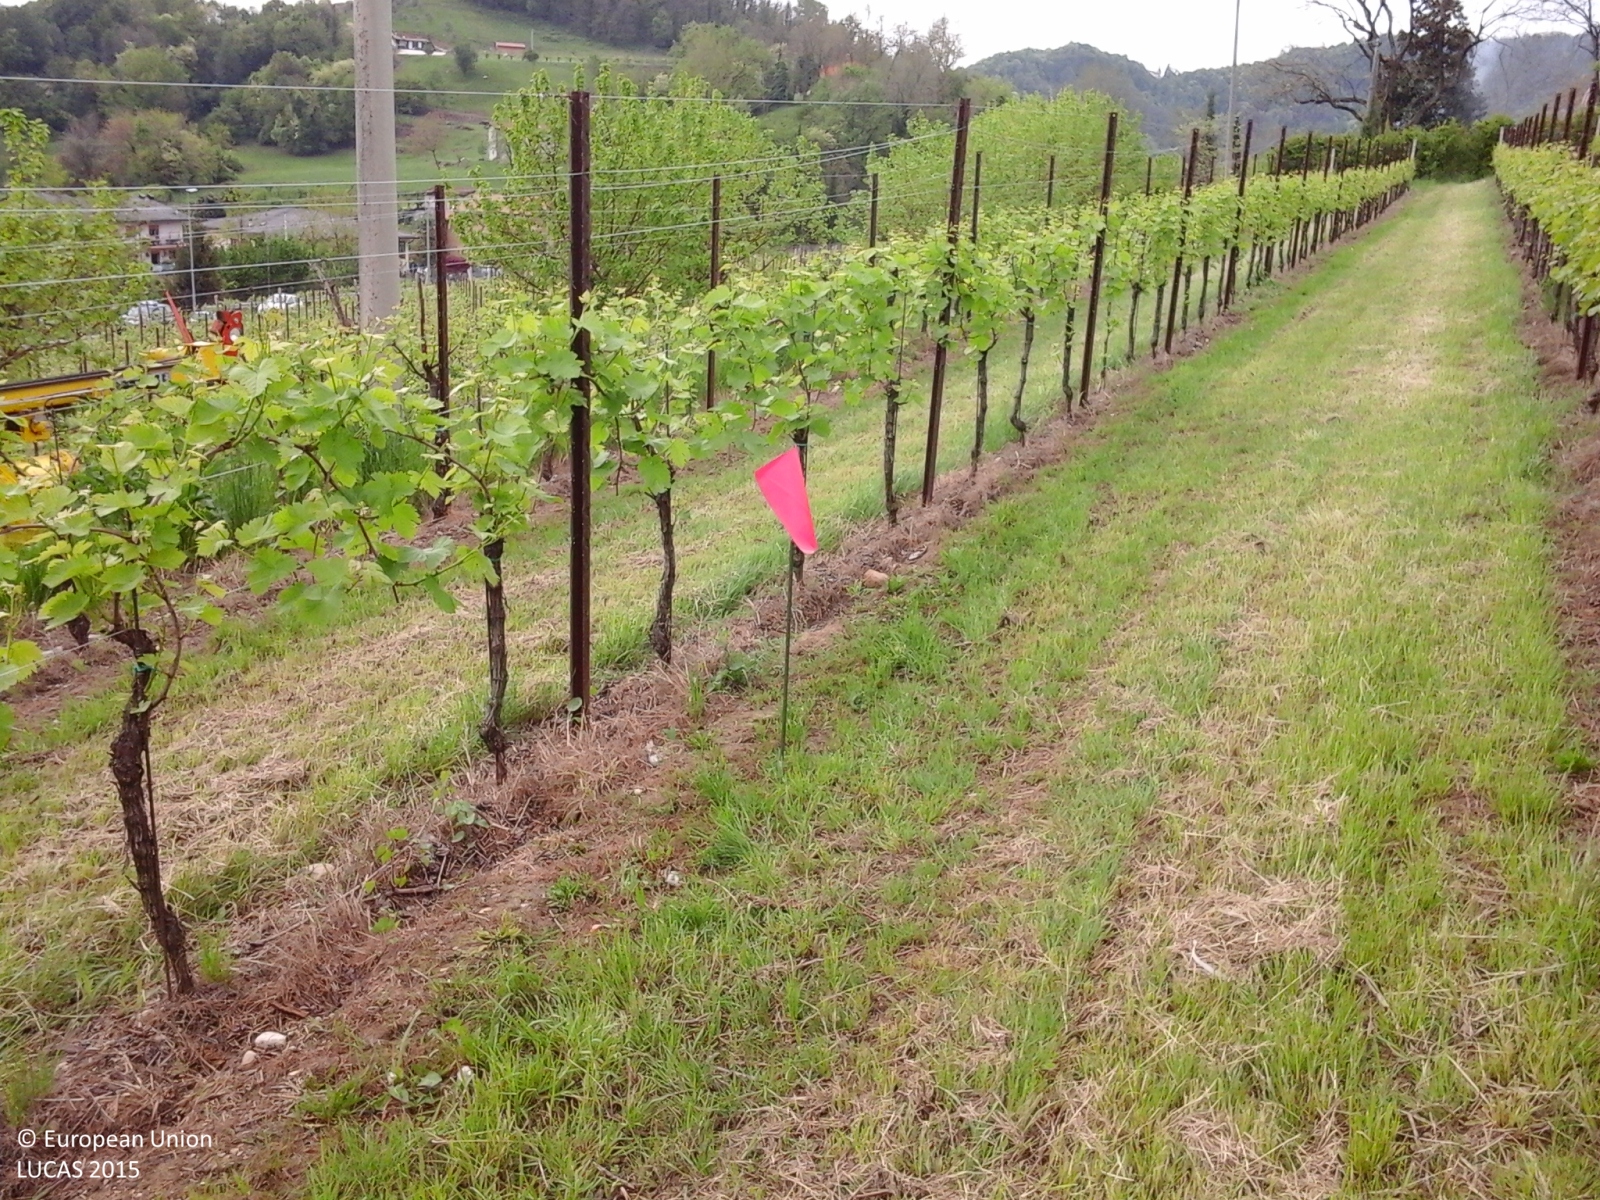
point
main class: Cropland
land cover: Vineyards
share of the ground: 10 - 25 %
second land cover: Grassland without tree/shrub cover
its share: > 75 %
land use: Agriculture (excluding fallow land and kitchen gardens)
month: April
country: IT
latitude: 45.9676
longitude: 12.2296
